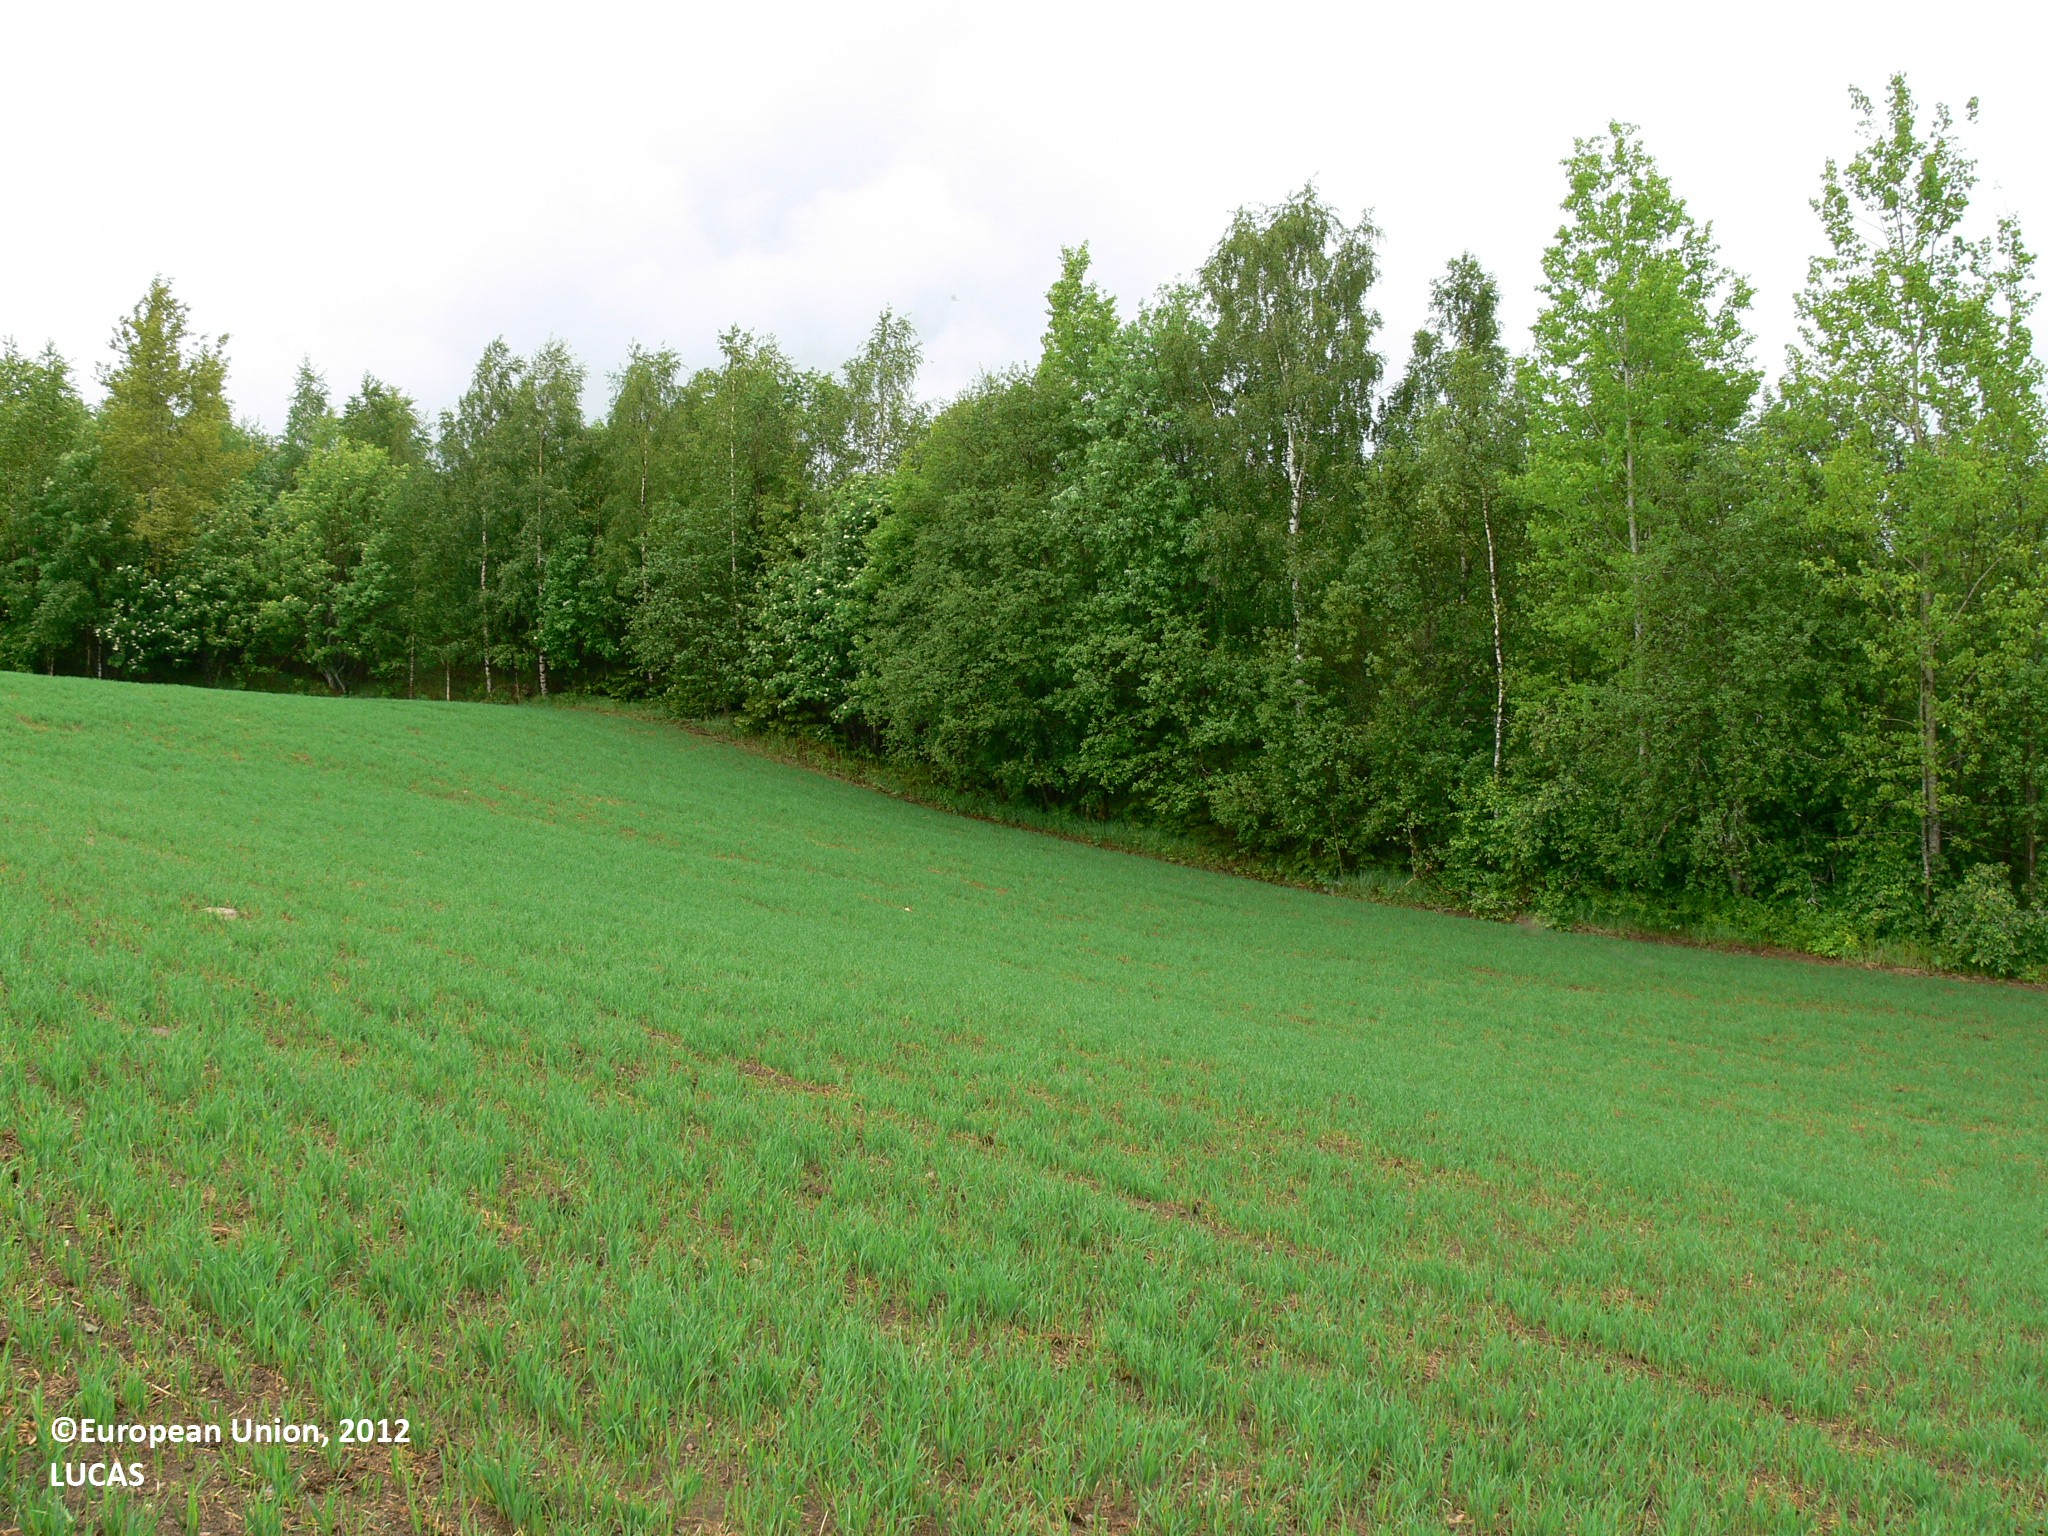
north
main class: Cropland
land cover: Oats
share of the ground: 25 - 50 %
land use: Agriculture (excluding fallow land and kitchen gardens)
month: June
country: FI
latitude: 62.4221
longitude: 30.4365
